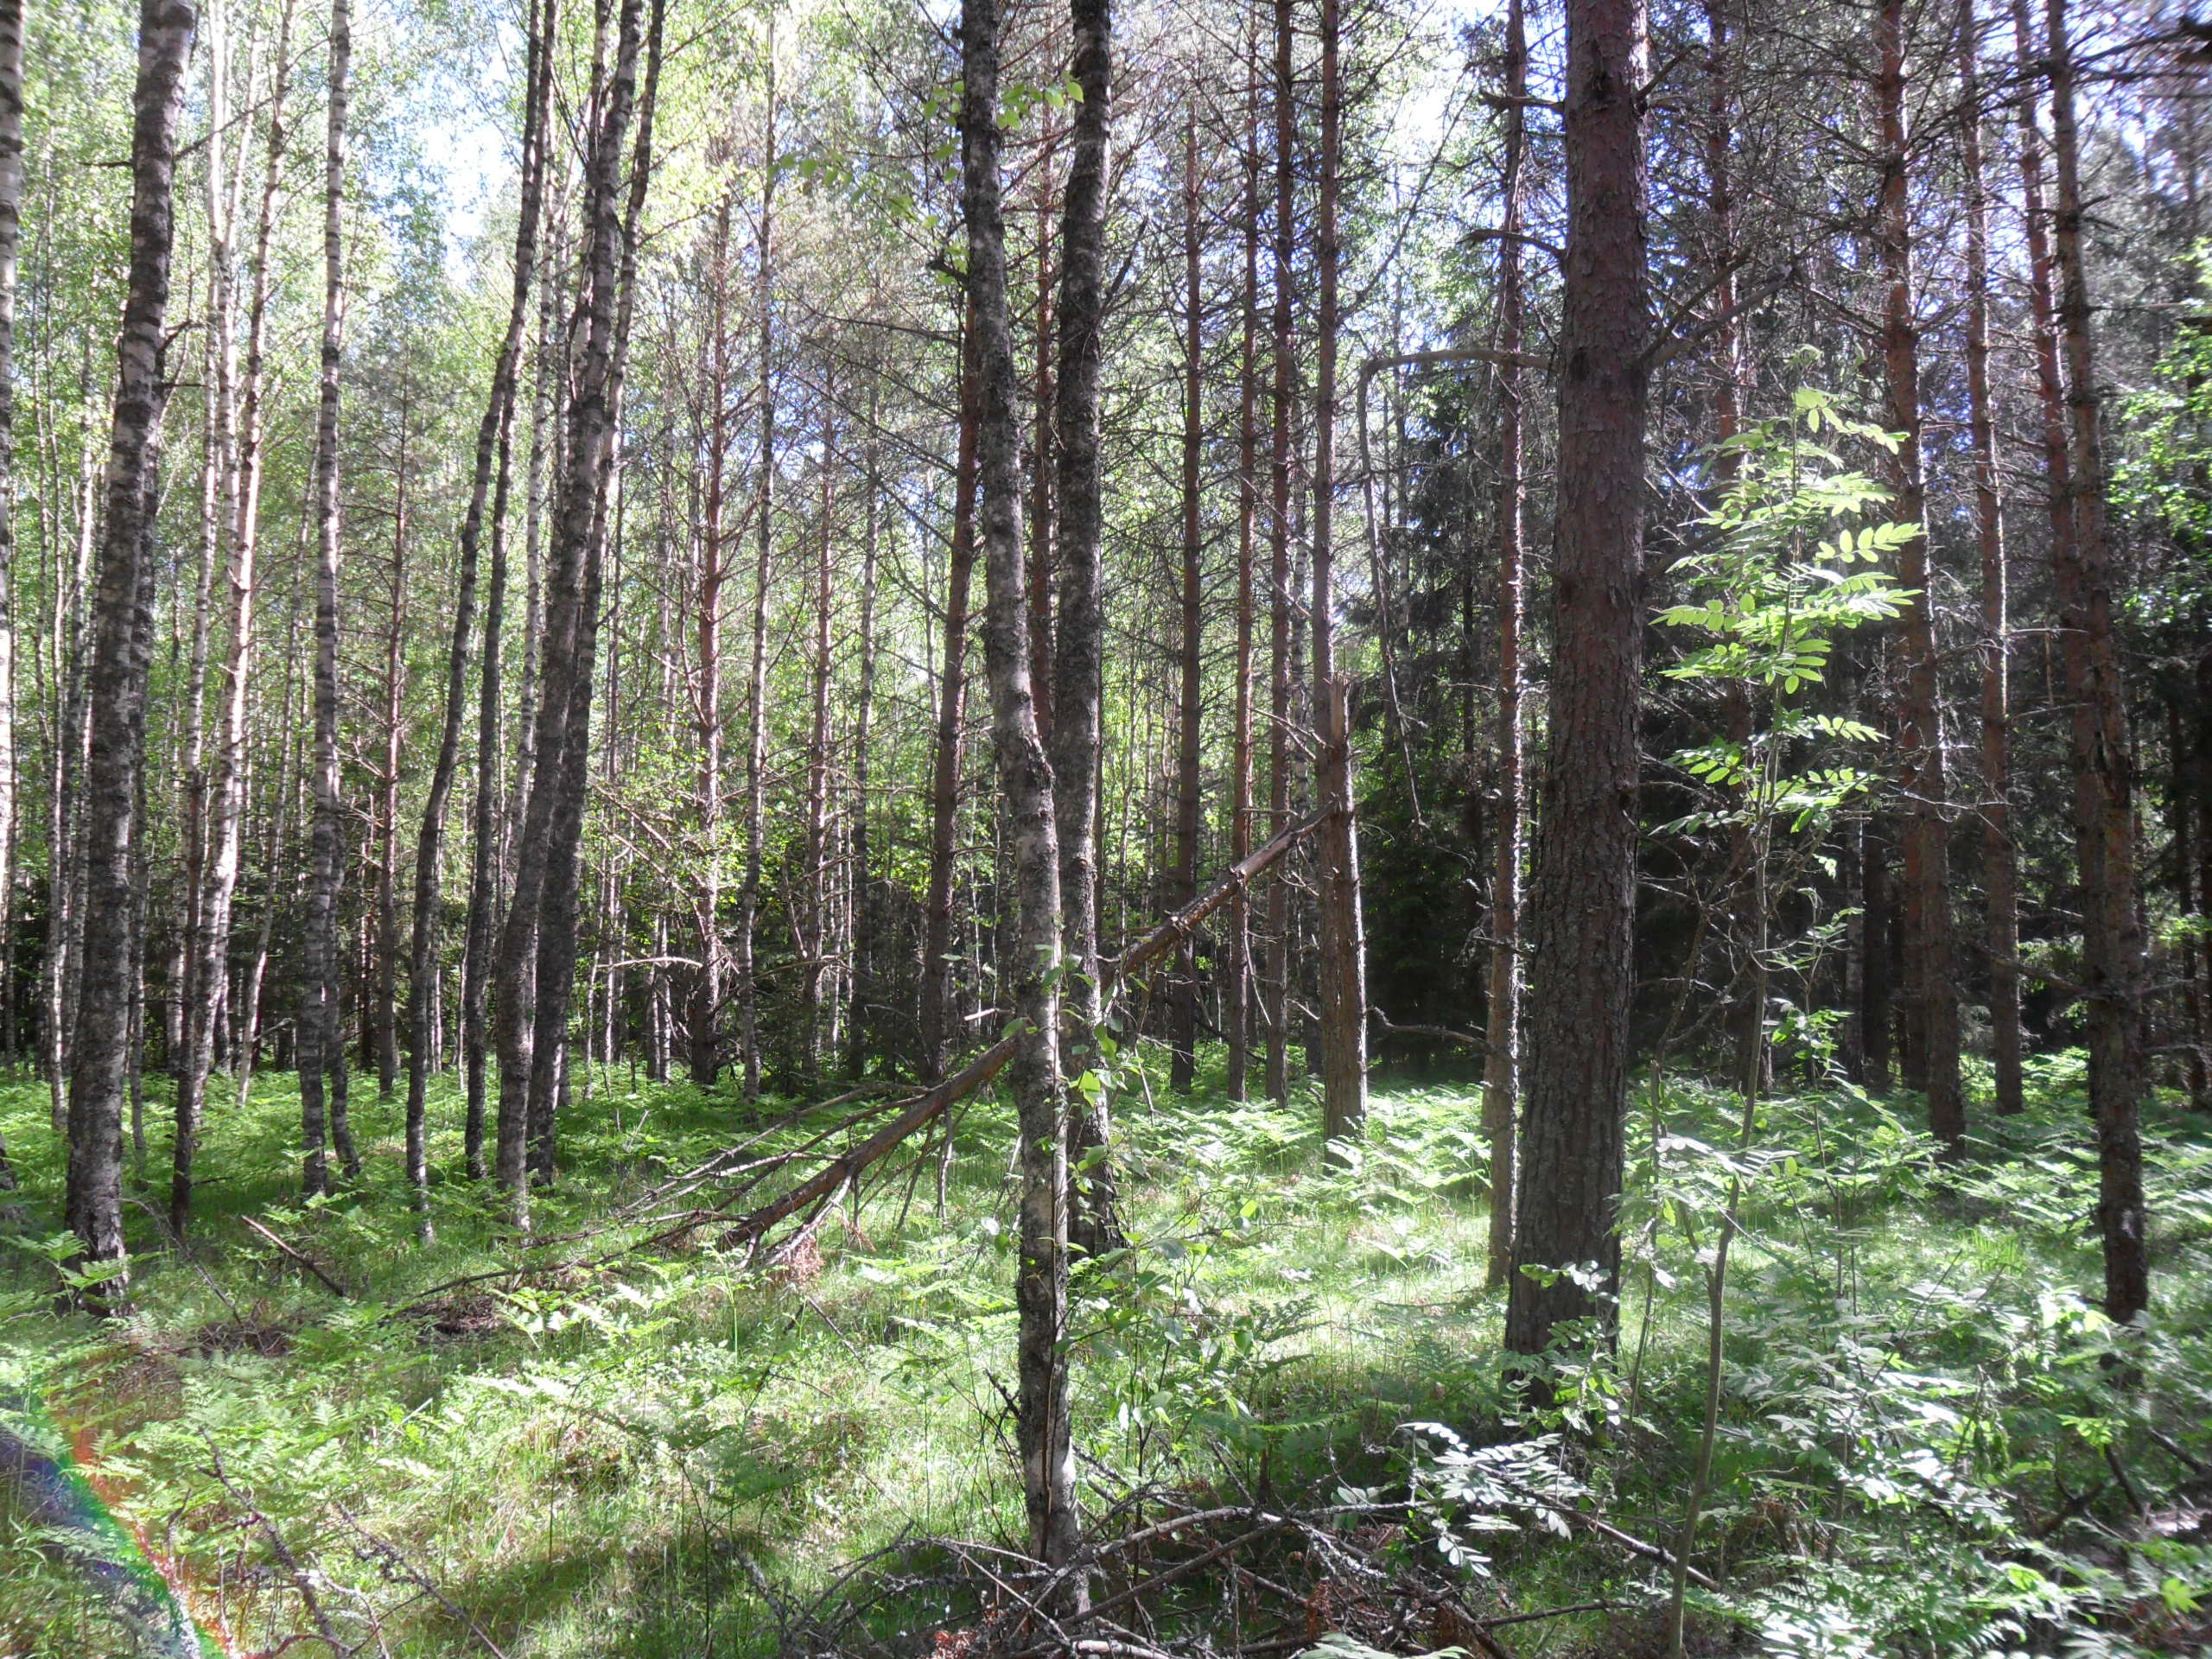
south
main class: Woodland
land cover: Pine dominated mixed woodland
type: hemiboreal forest and nemoral coniferous forest and mixed broadleaved-coniferous forest
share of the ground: > 75 %
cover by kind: coniferous forest trees 60 %, broadleaved forest trees 20 %, herbaceous plants 20 %
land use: Forestry
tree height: > 5 m
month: June
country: LV
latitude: 57.5253
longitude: 22.2895
